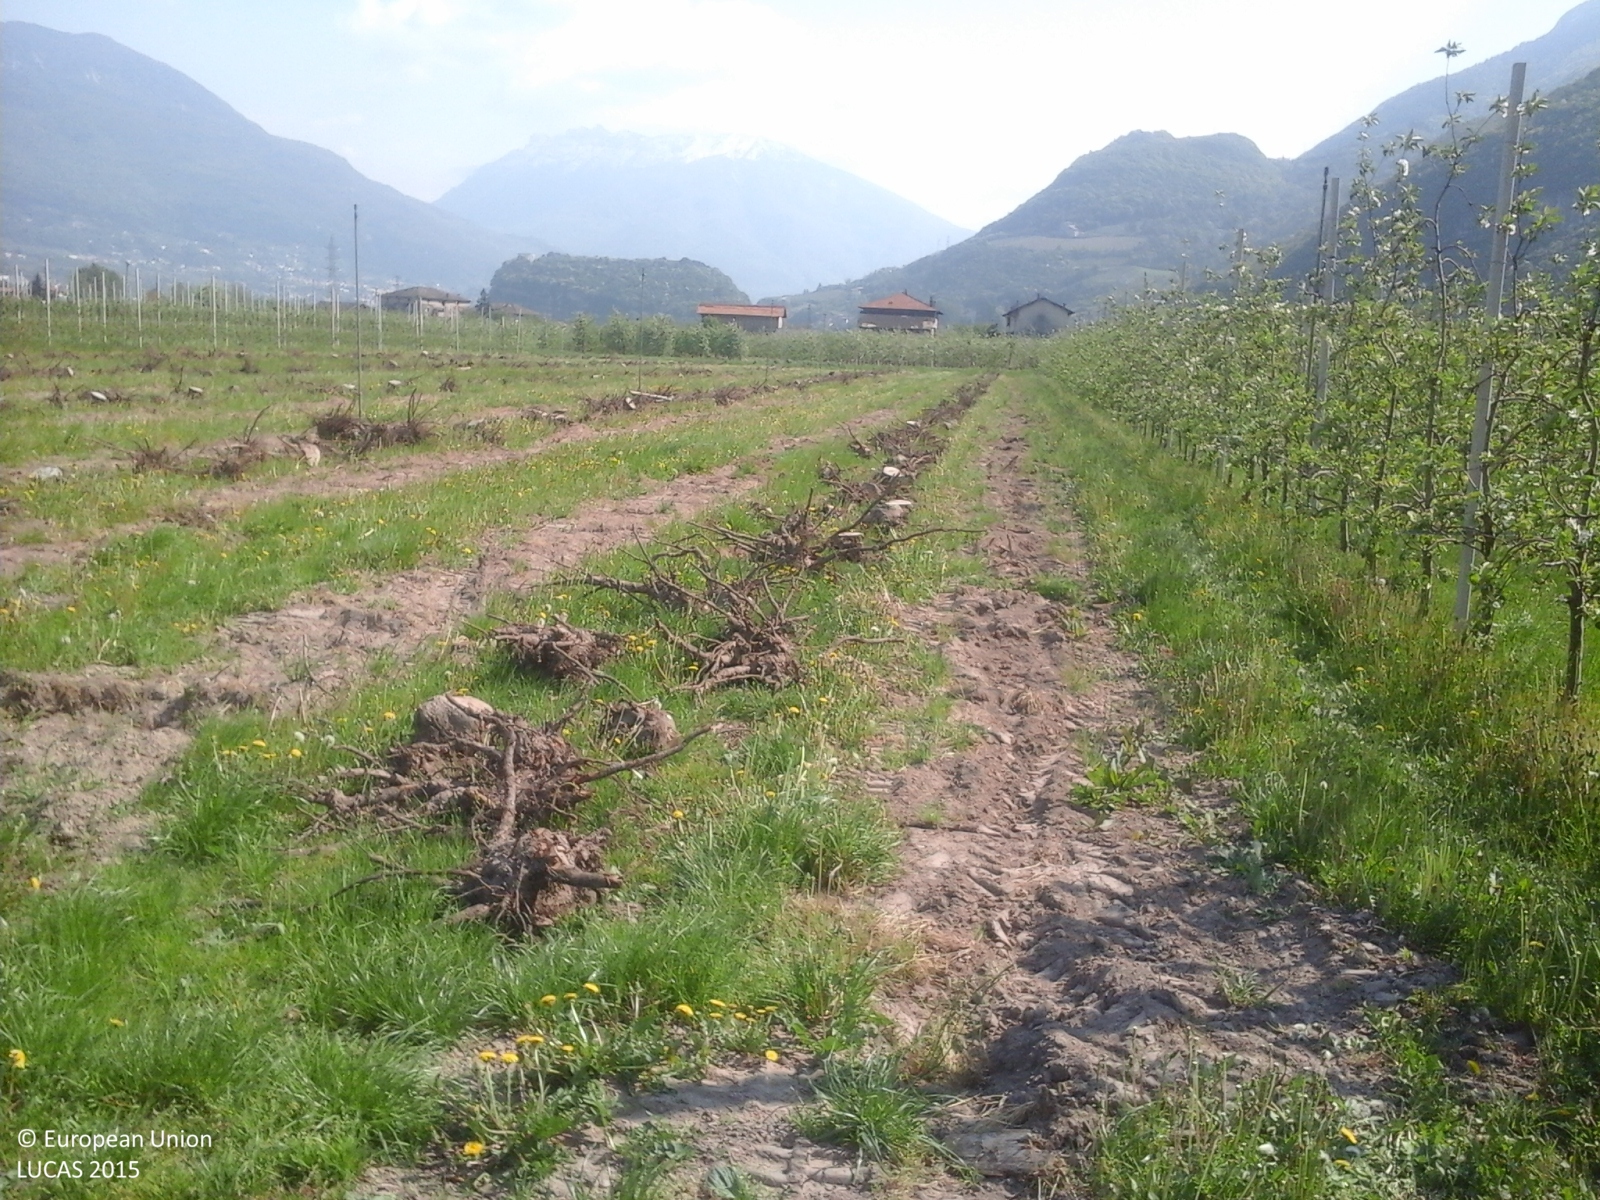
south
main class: Grassland
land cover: Spontaneously vegetated surfaces
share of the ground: > 75 %
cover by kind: herbaceous plants 90 %, unconsolidated bare surface 10 %
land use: Fallow land
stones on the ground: < 10 %
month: April
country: IT
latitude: 46.0934
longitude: 11.0978
